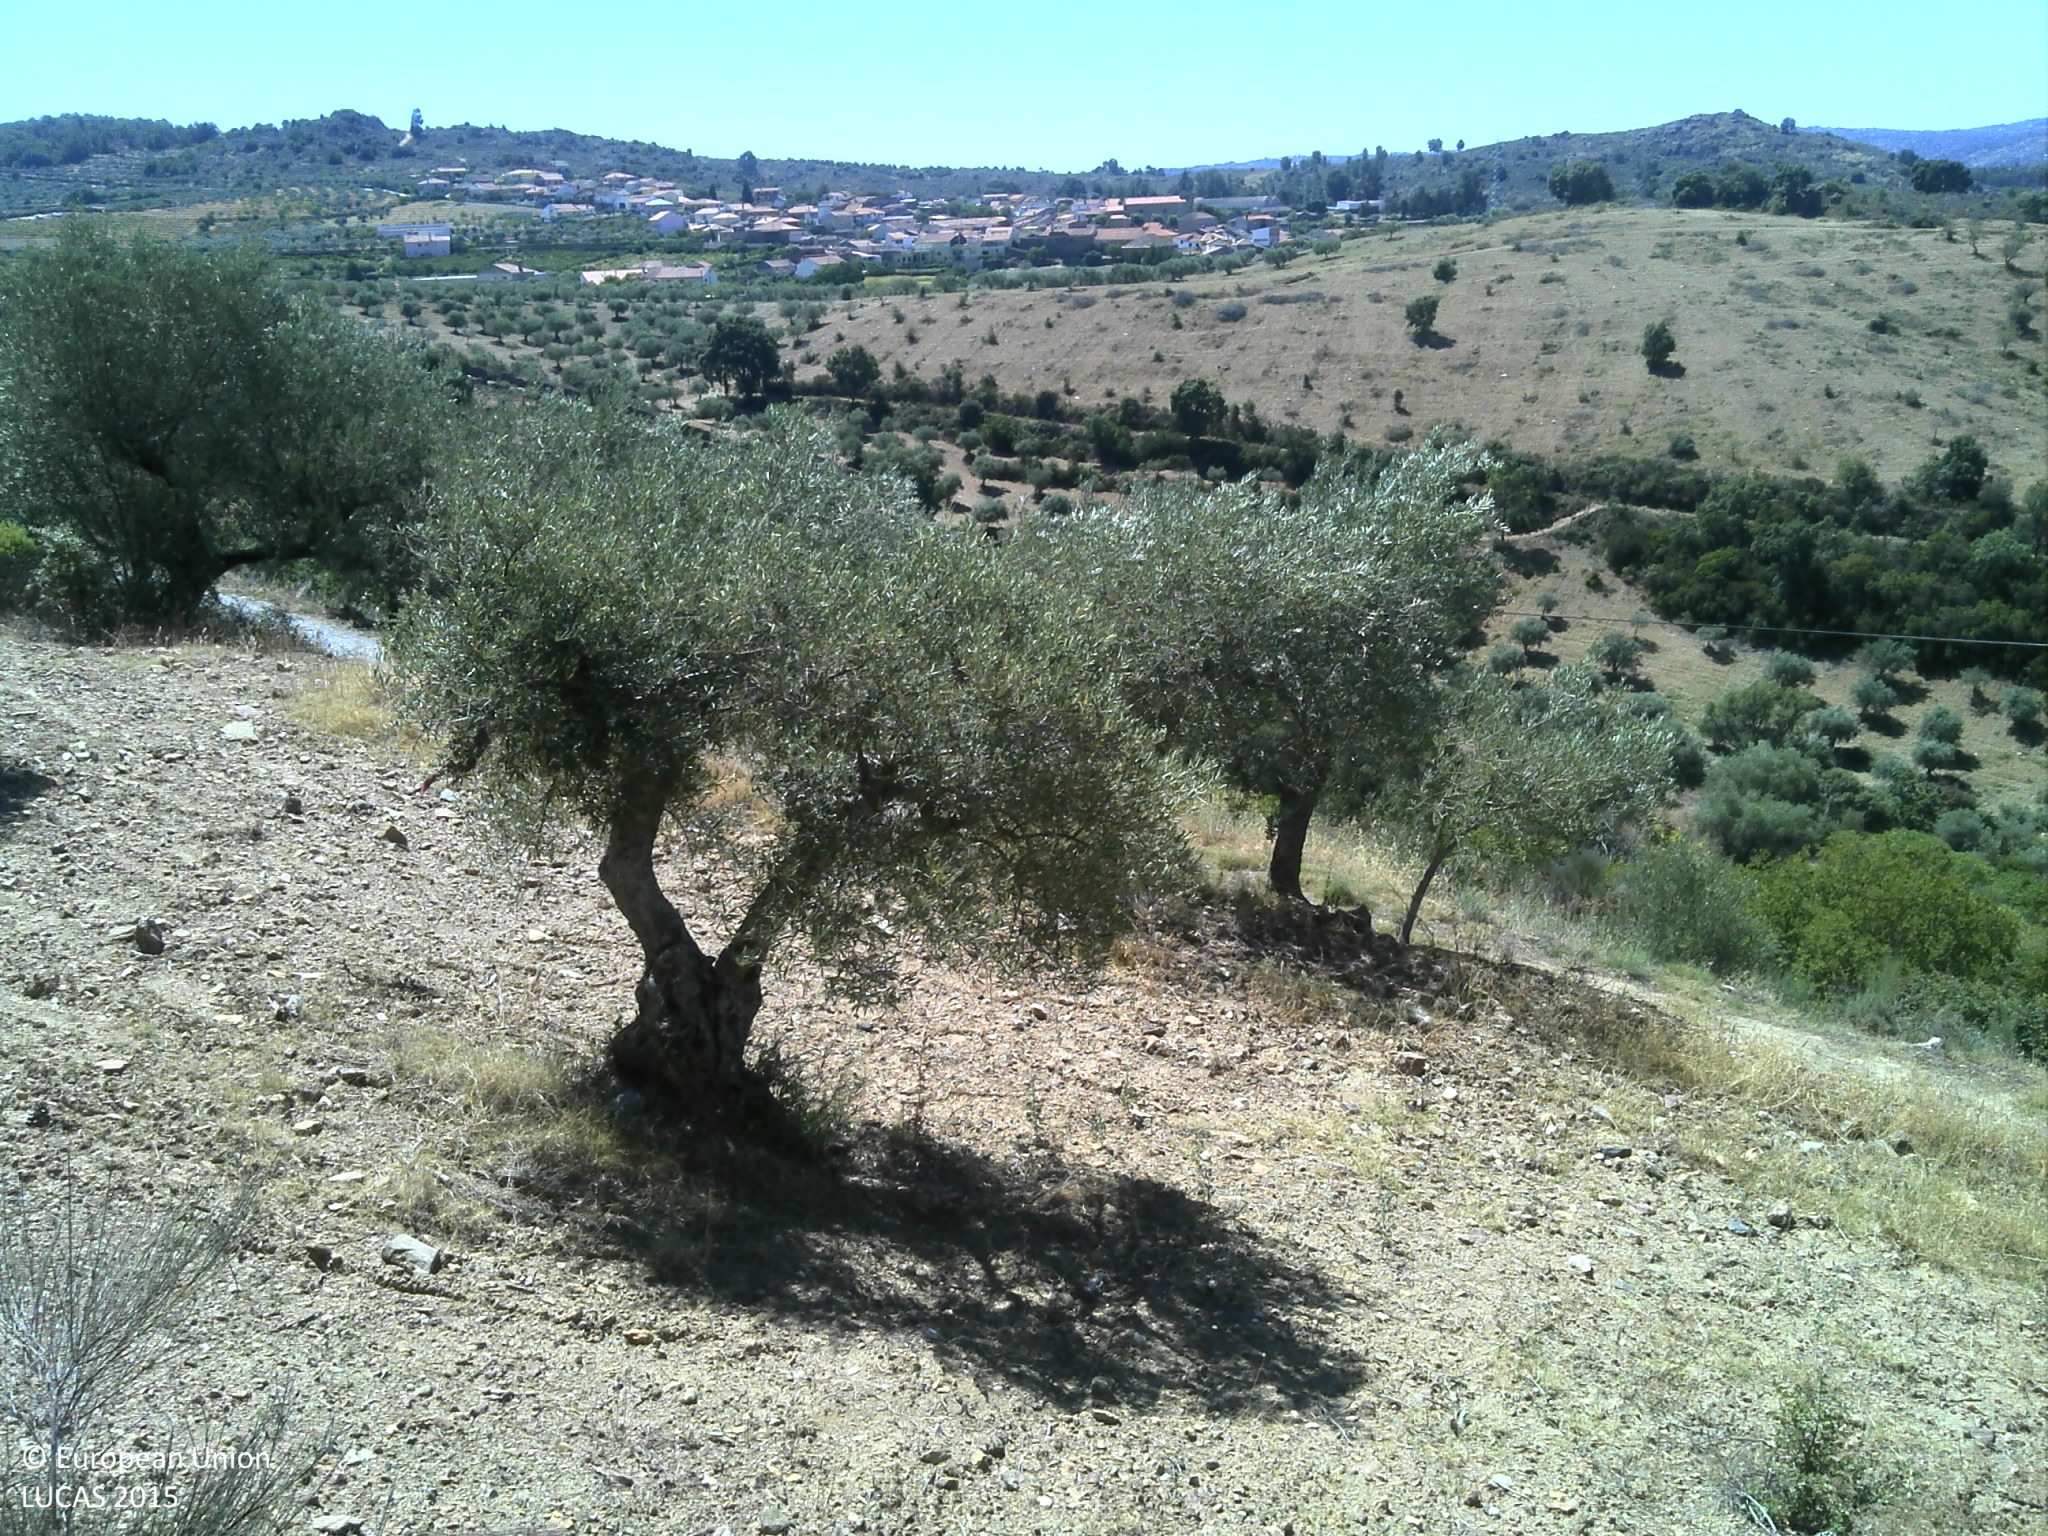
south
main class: Woodland
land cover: Pine dominated coniferous woodland
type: coniferous forest of the mediterranean region
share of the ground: 10 - 25 %
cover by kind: shrubs 35 %, unconsolidated bare surface 20 %, coniferous forest trees 15 %, herbaceous plants 10 %, consolidated bare surface 10 %
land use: Forestry
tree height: > 5 m
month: July
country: PT
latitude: 41.3543
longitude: -7.1977
